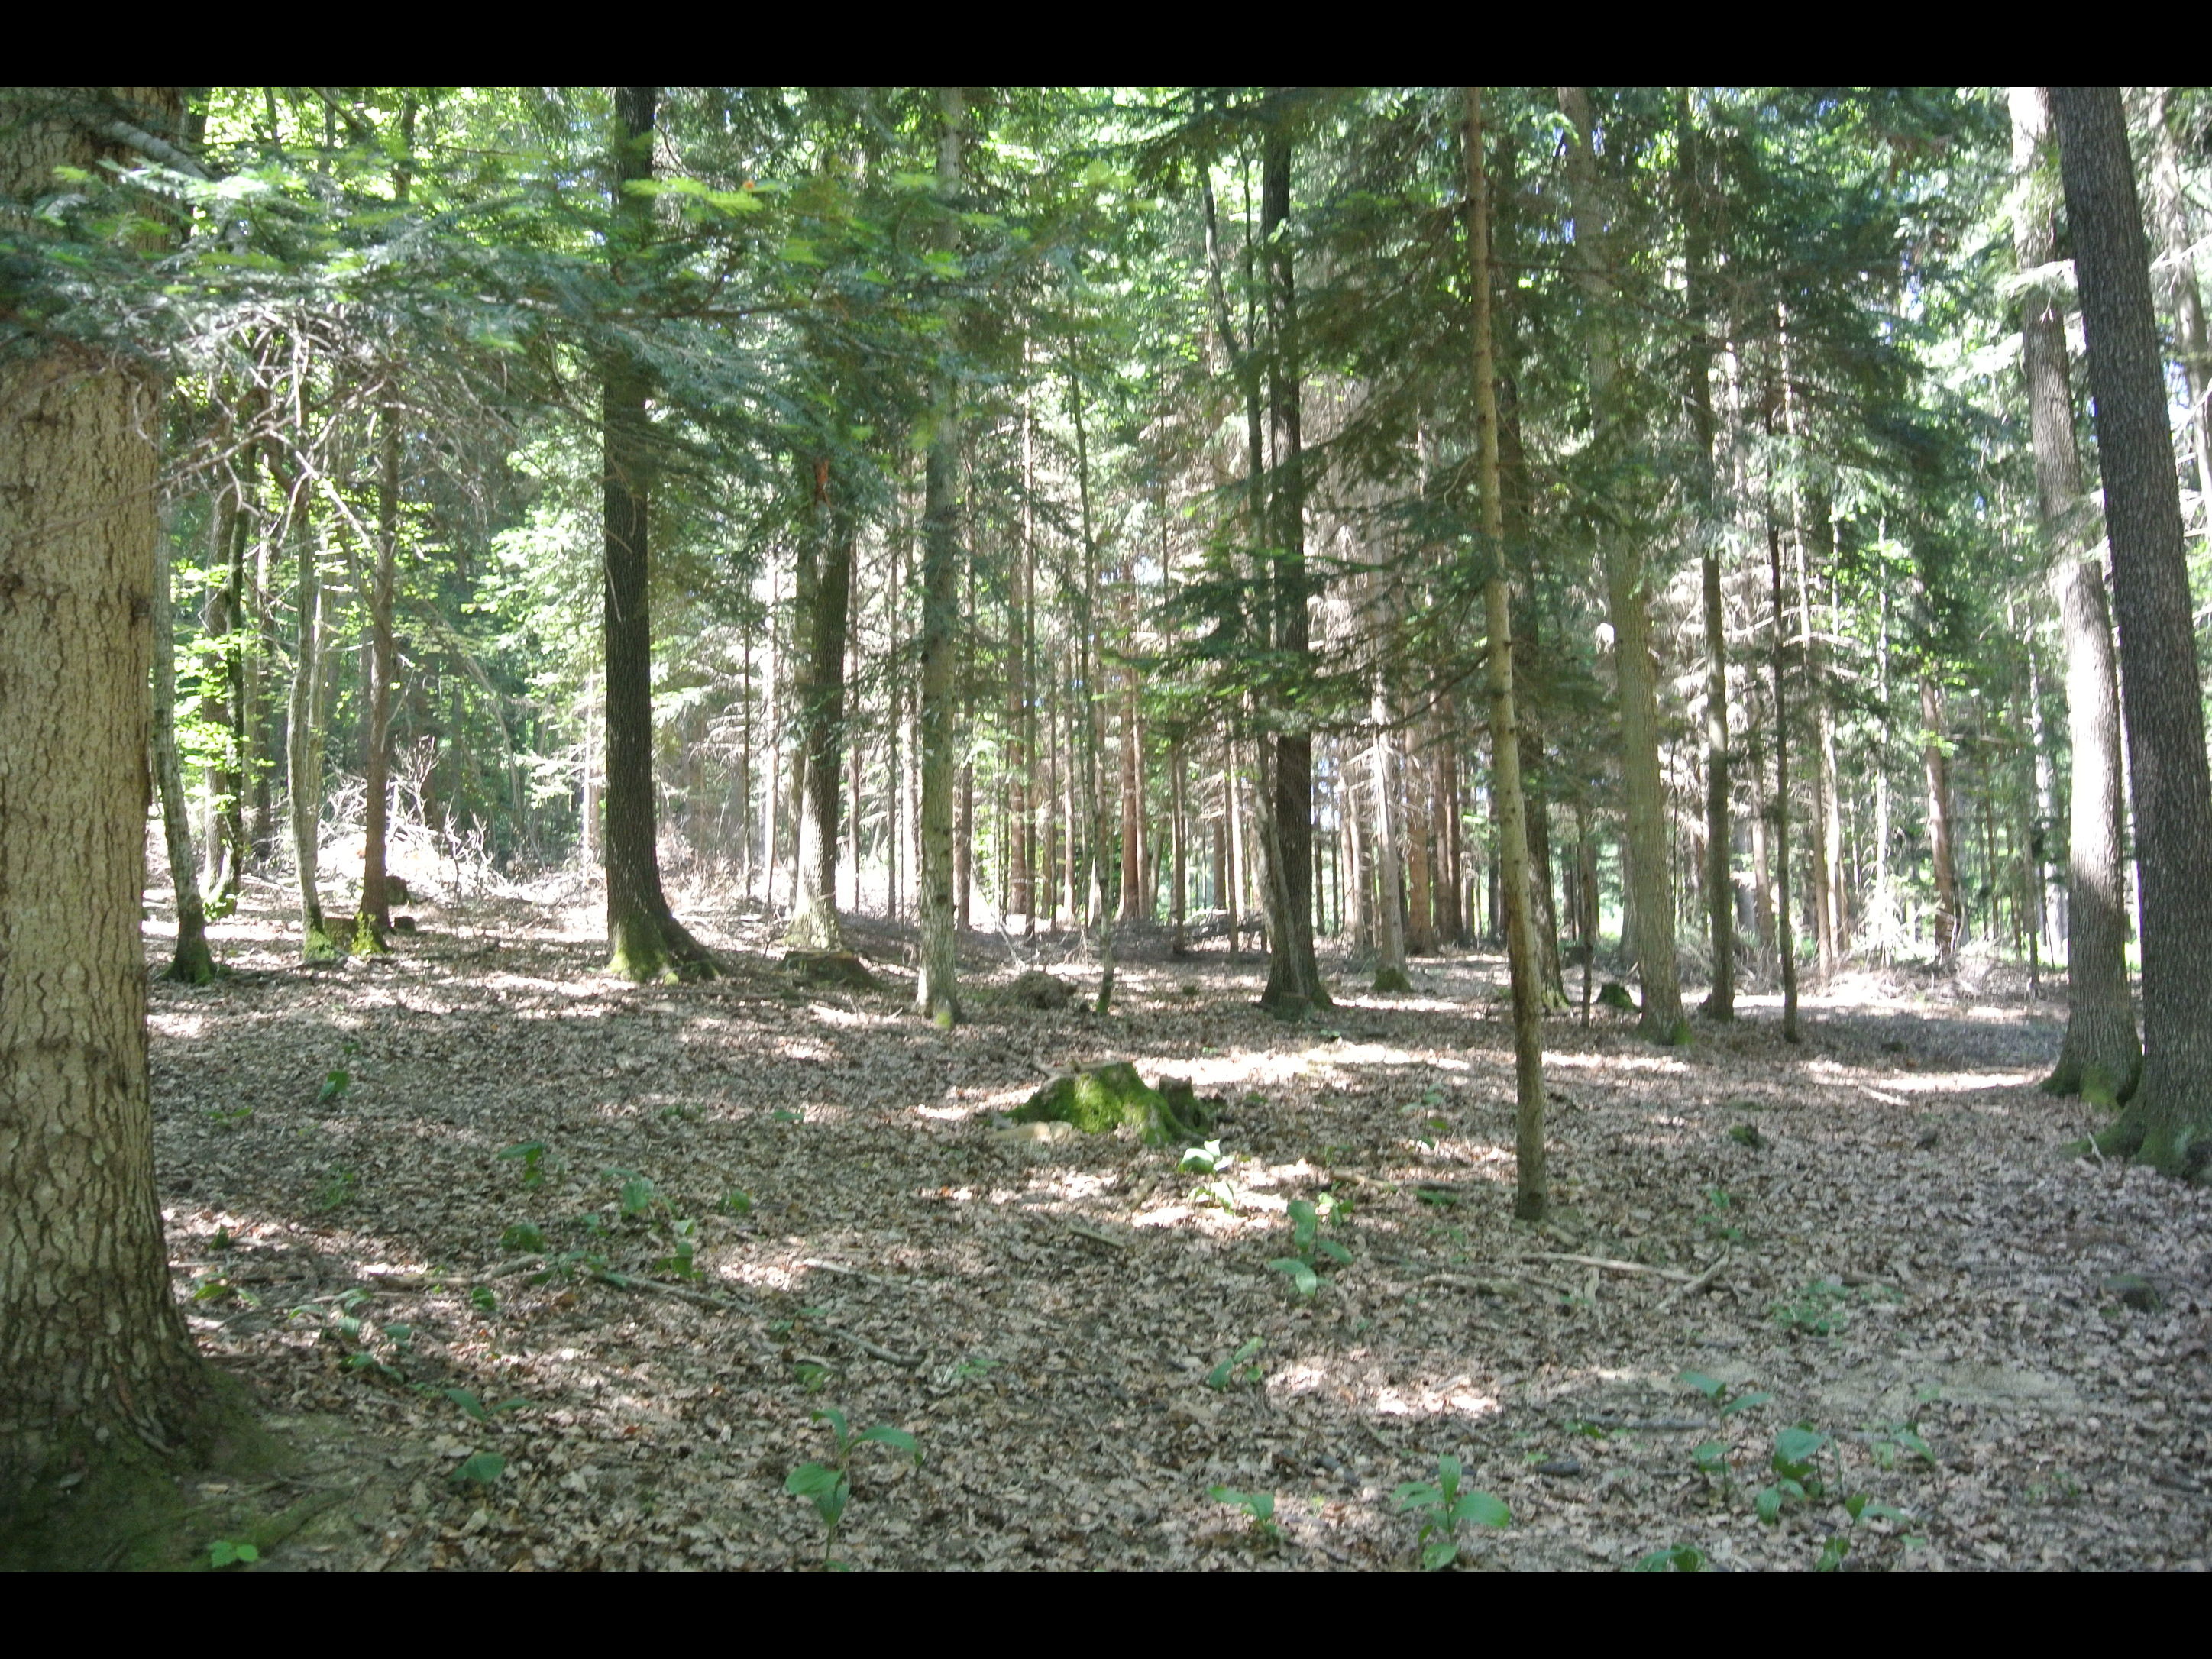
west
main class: Woodland
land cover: Spruce dominated mixed woodland
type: alpine coniferous forest
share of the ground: > 75 %
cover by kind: broadleaved forest trees 55 %, coniferous forest trees 35 %, shrubs 5 %, herbaceous plants 5 %
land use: Forestry
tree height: > 5 m
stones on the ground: < 10 %
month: June
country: AT
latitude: 48.0493
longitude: 15.8655
